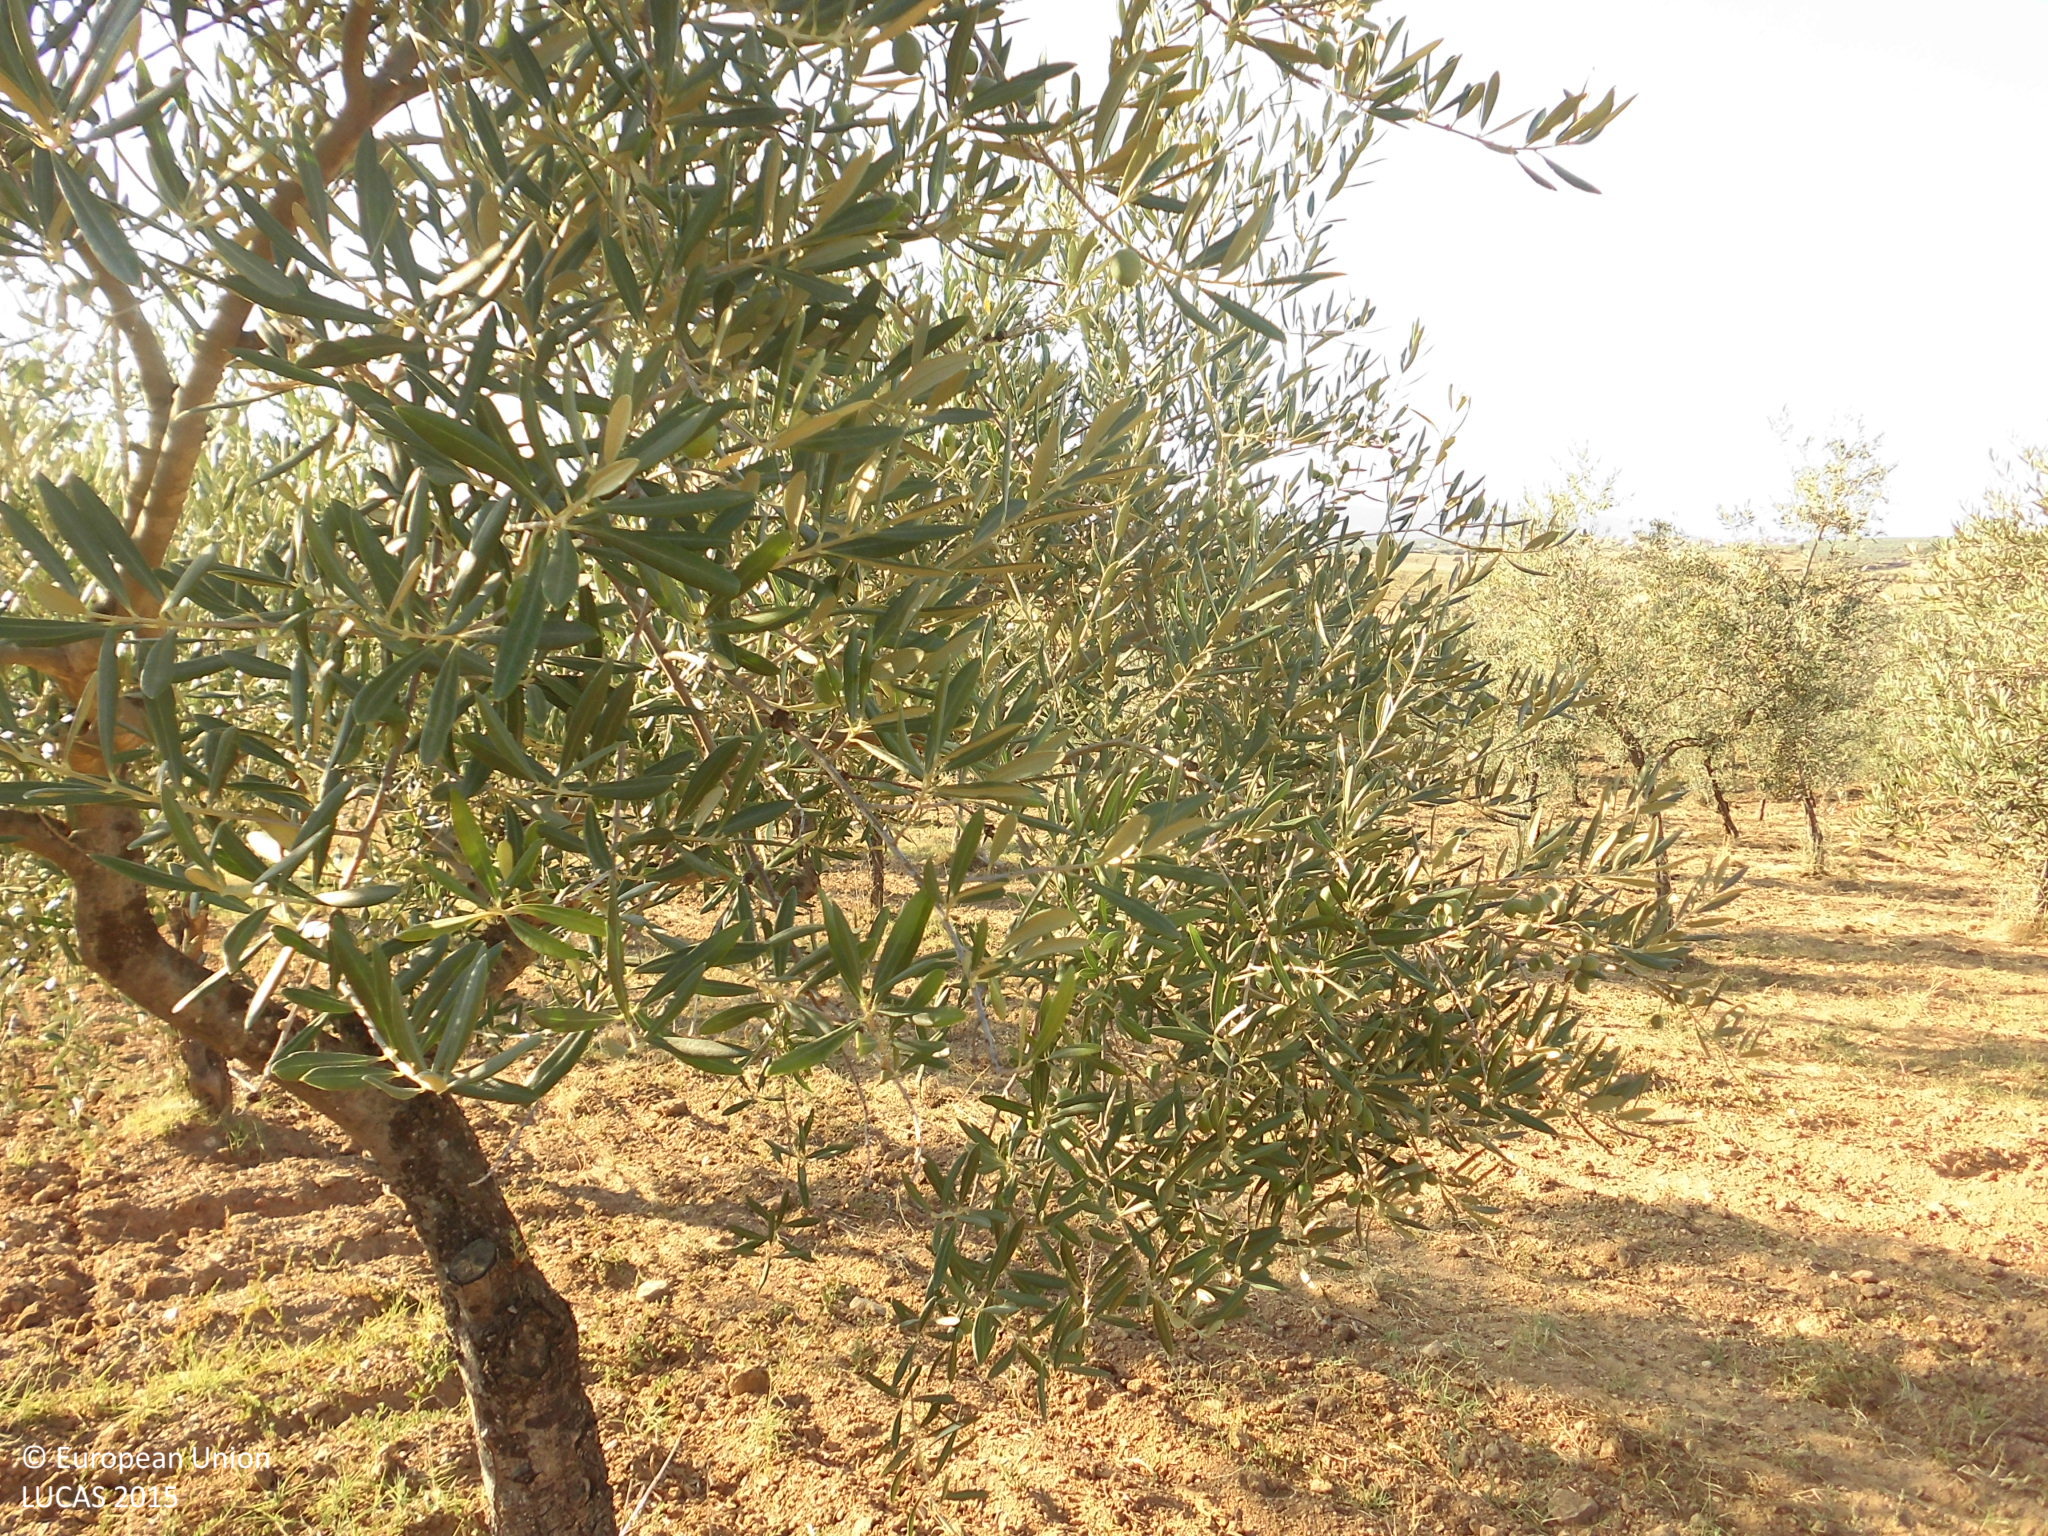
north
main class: Cropland
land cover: Olive groves
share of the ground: 25 - 50 %
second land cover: Other bare soil
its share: > 75 %
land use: Agriculture (excluding fallow land and kitchen gardens)
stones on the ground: < 10 %
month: July
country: ES
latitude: 40.1632
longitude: -6.1965
